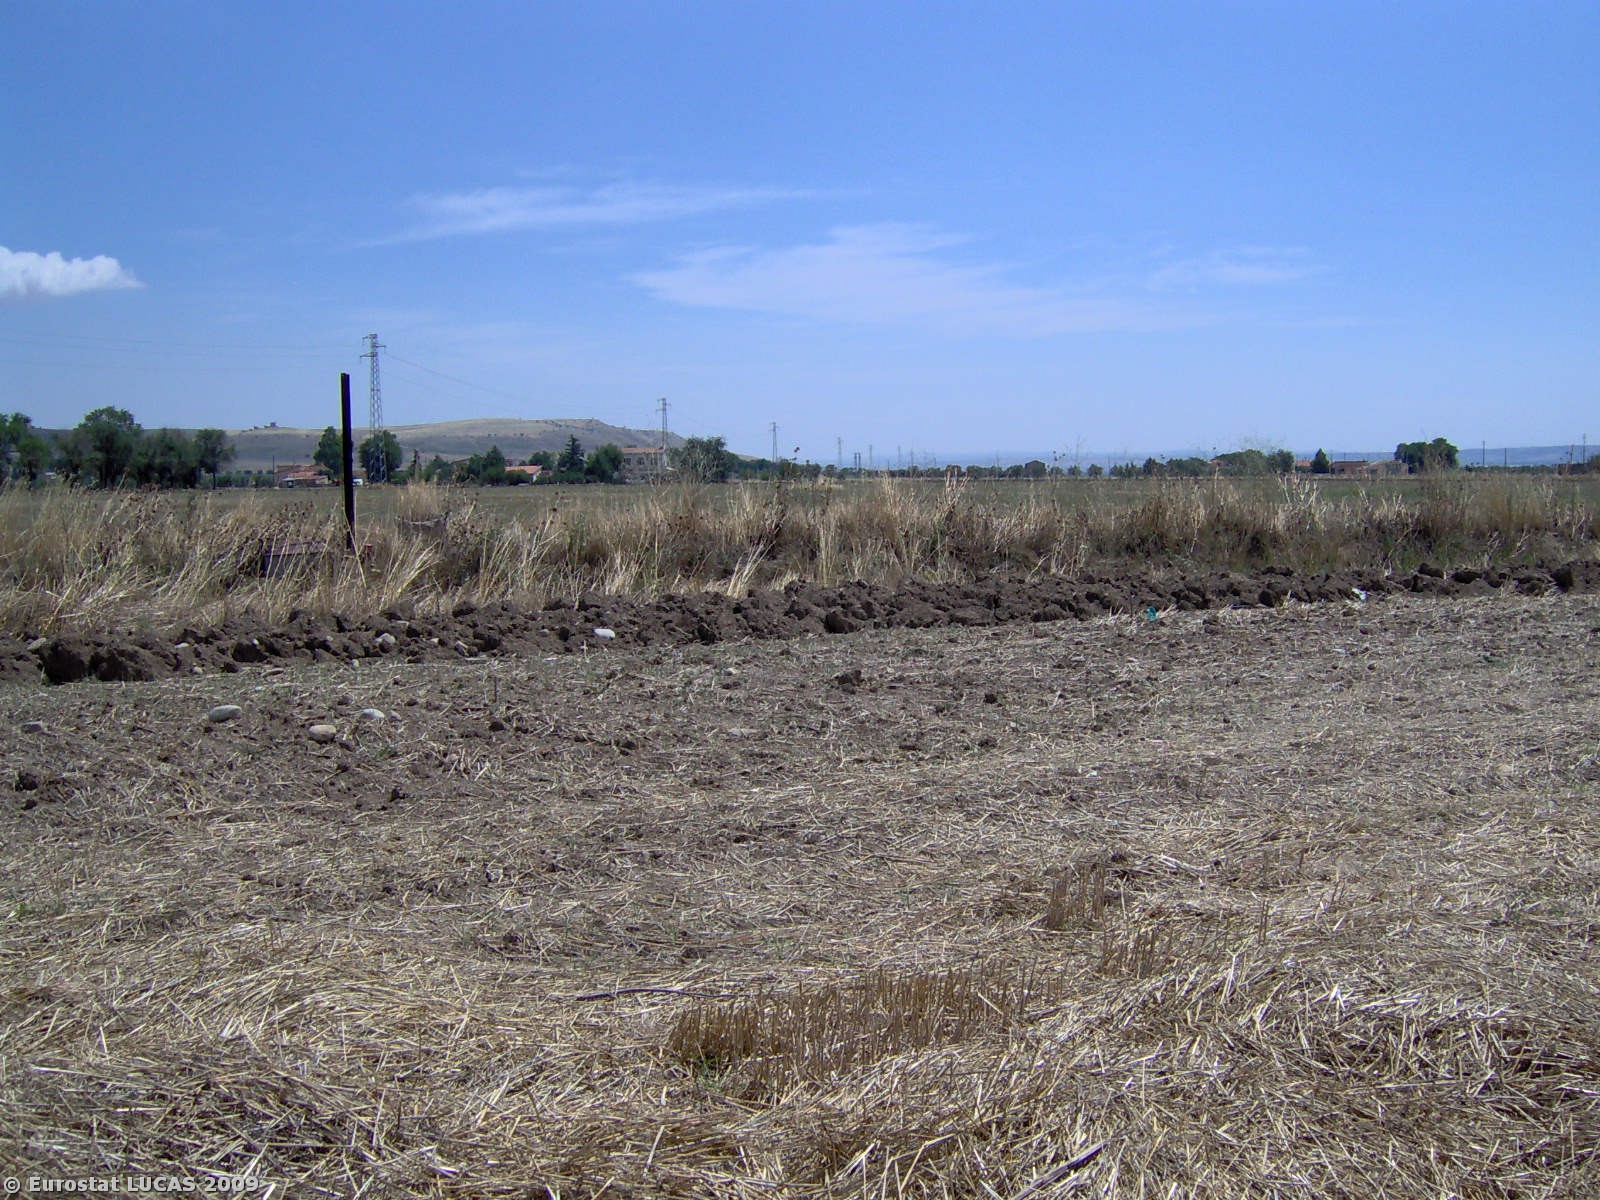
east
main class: Cropland
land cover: Durum wheat
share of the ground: < 10 %
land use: Agriculture (excluding fallow land and kitchen gardens)
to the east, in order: Durum wheat; Ditches and canals; Durum wheat; Tracks; Durum wheat
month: July
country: IT
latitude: 41.1011
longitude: 15.6596
